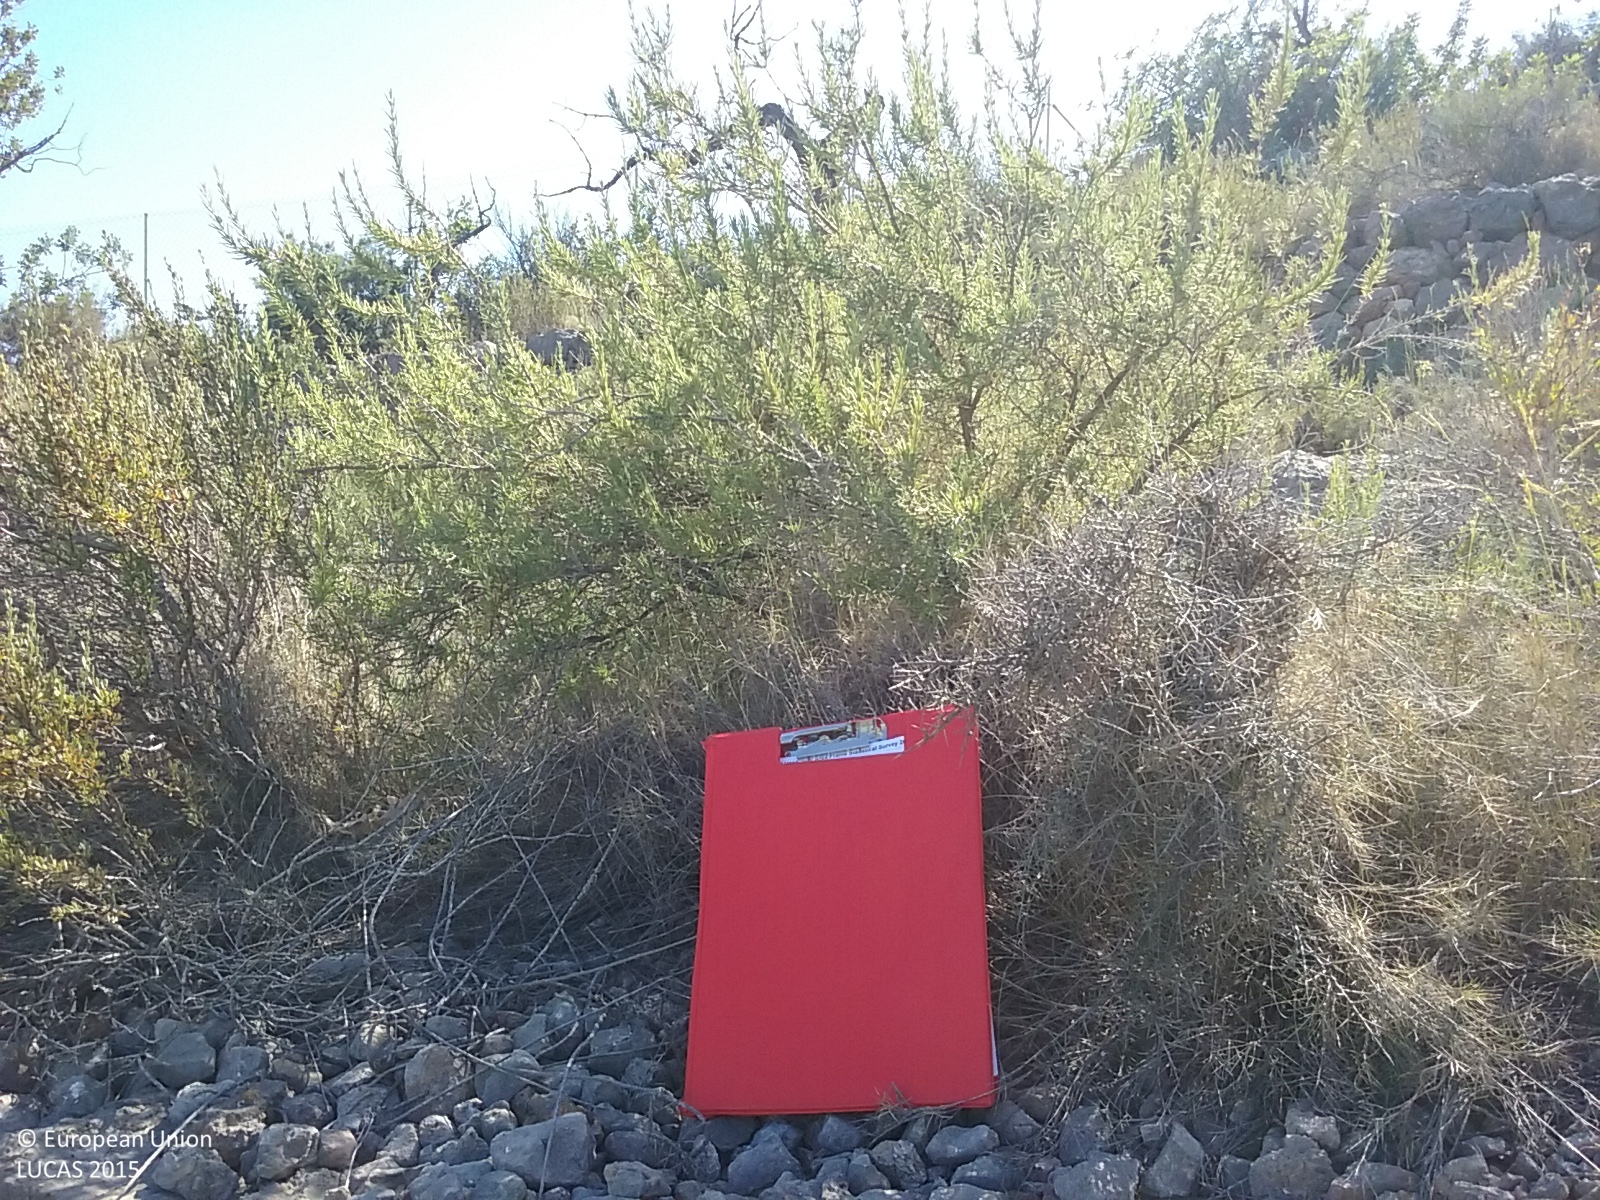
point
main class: Cropland
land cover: Permanent industrial crops
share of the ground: < 10 %
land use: Abandoned areas
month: June
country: ES
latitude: 40.0240
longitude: -0.0432
